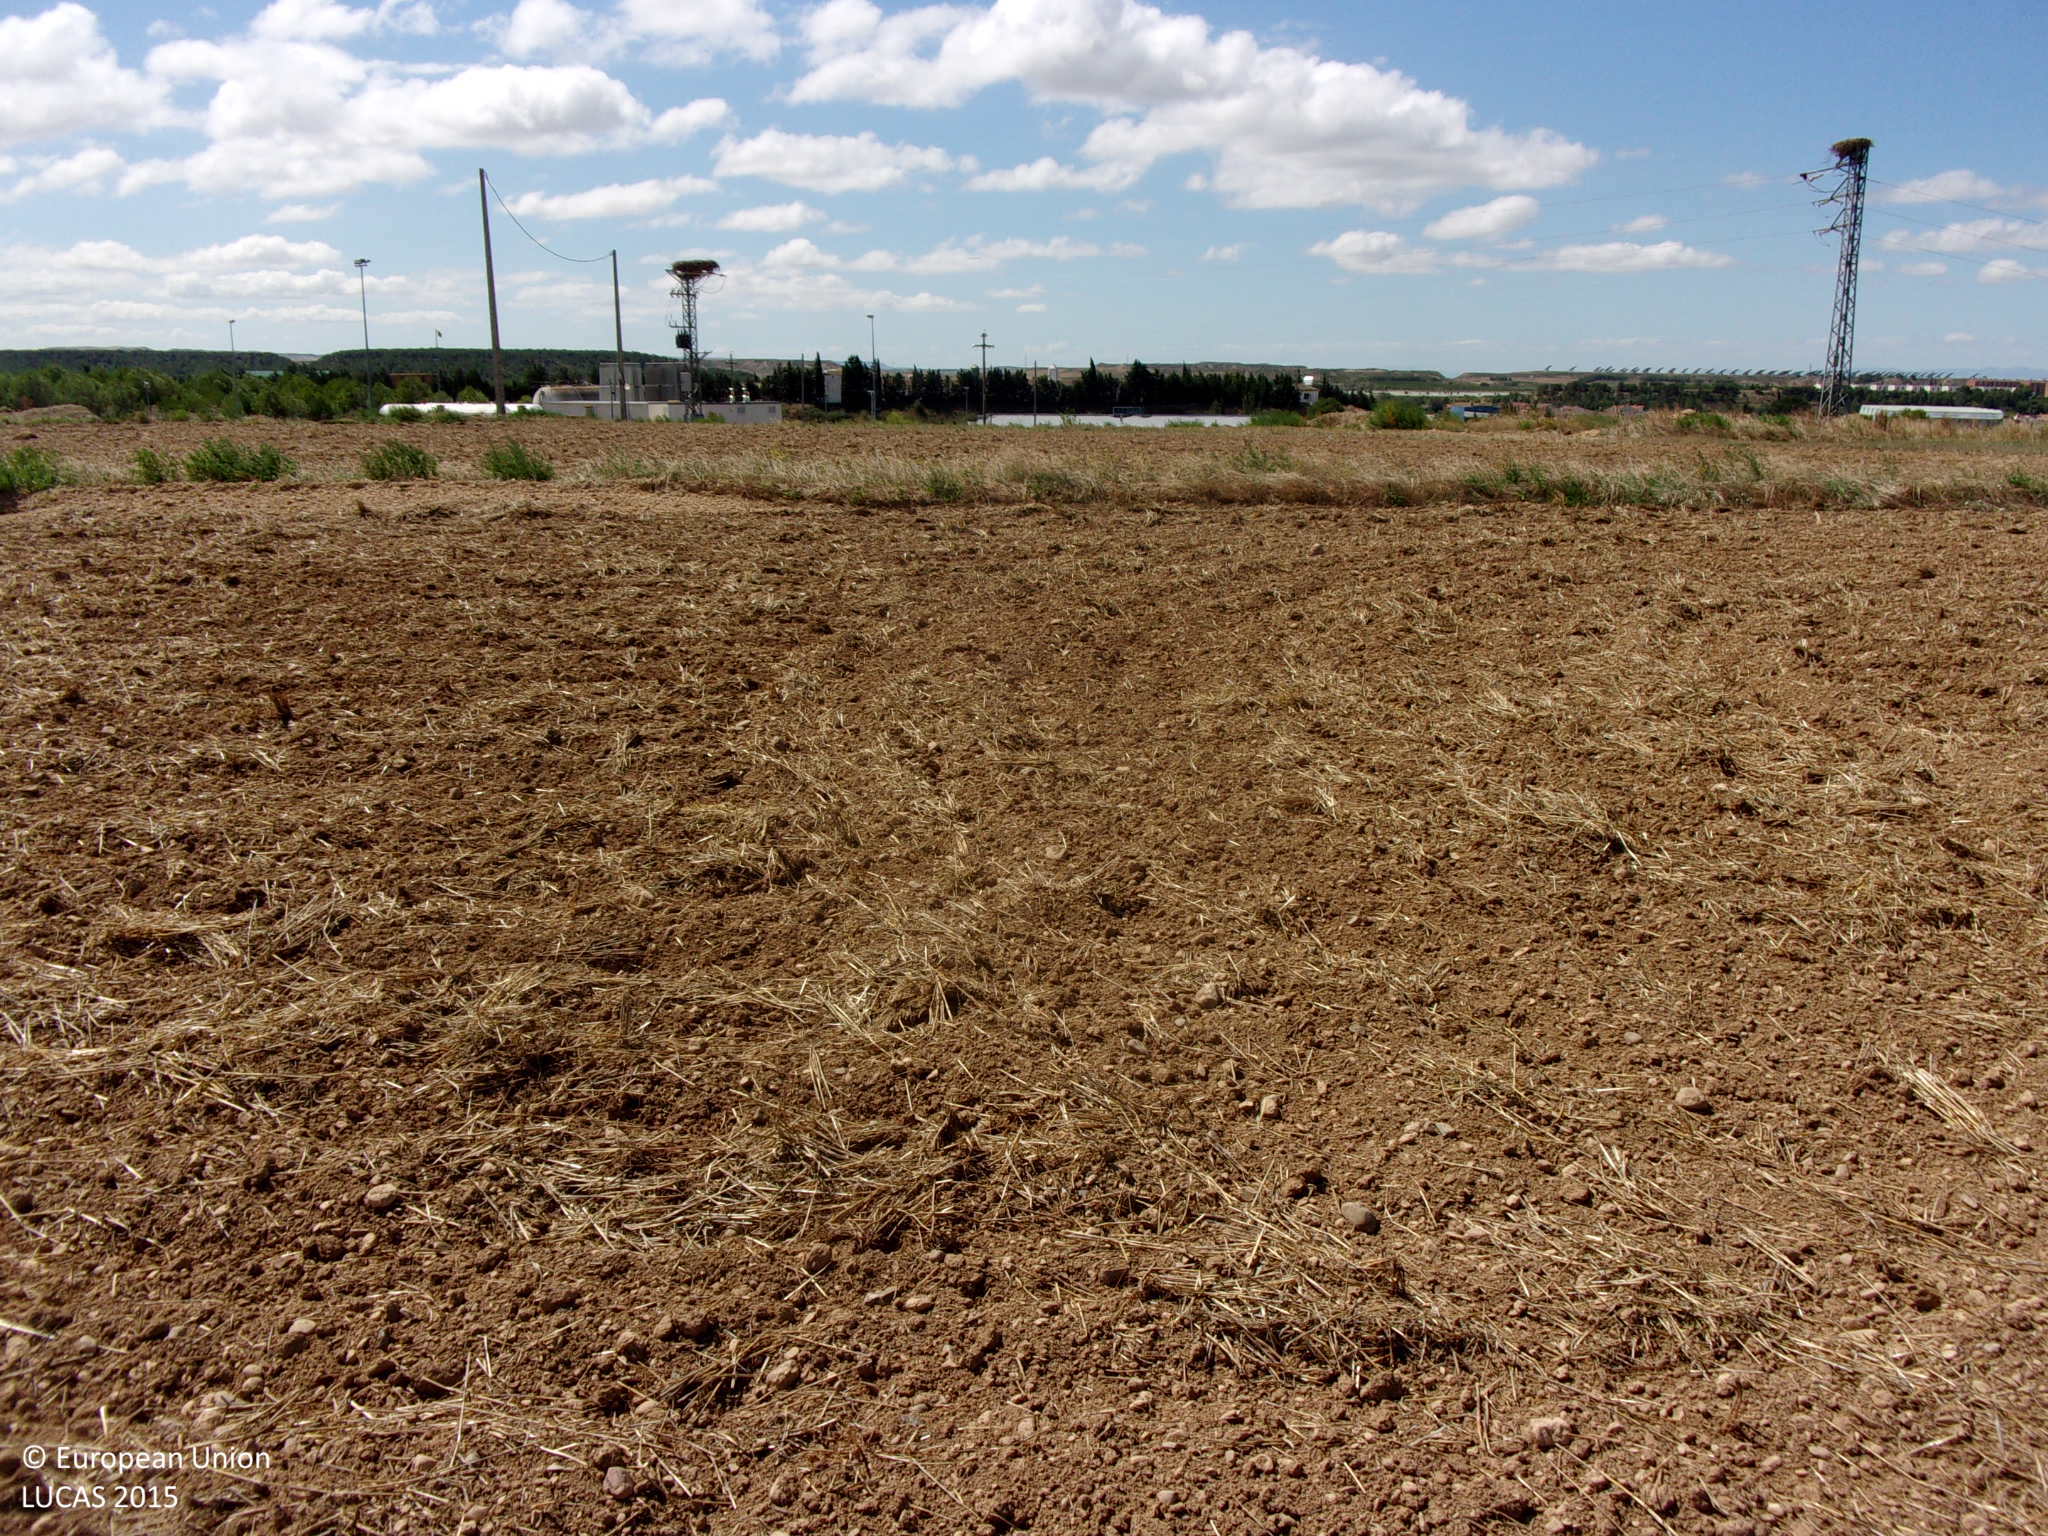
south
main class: Cropland
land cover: Barley
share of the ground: < 10 %
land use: Agriculture (excluding fallow land and kitchen gardens)
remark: Harvested field
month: August
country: ES
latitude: 42.1307
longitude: -1.1215
